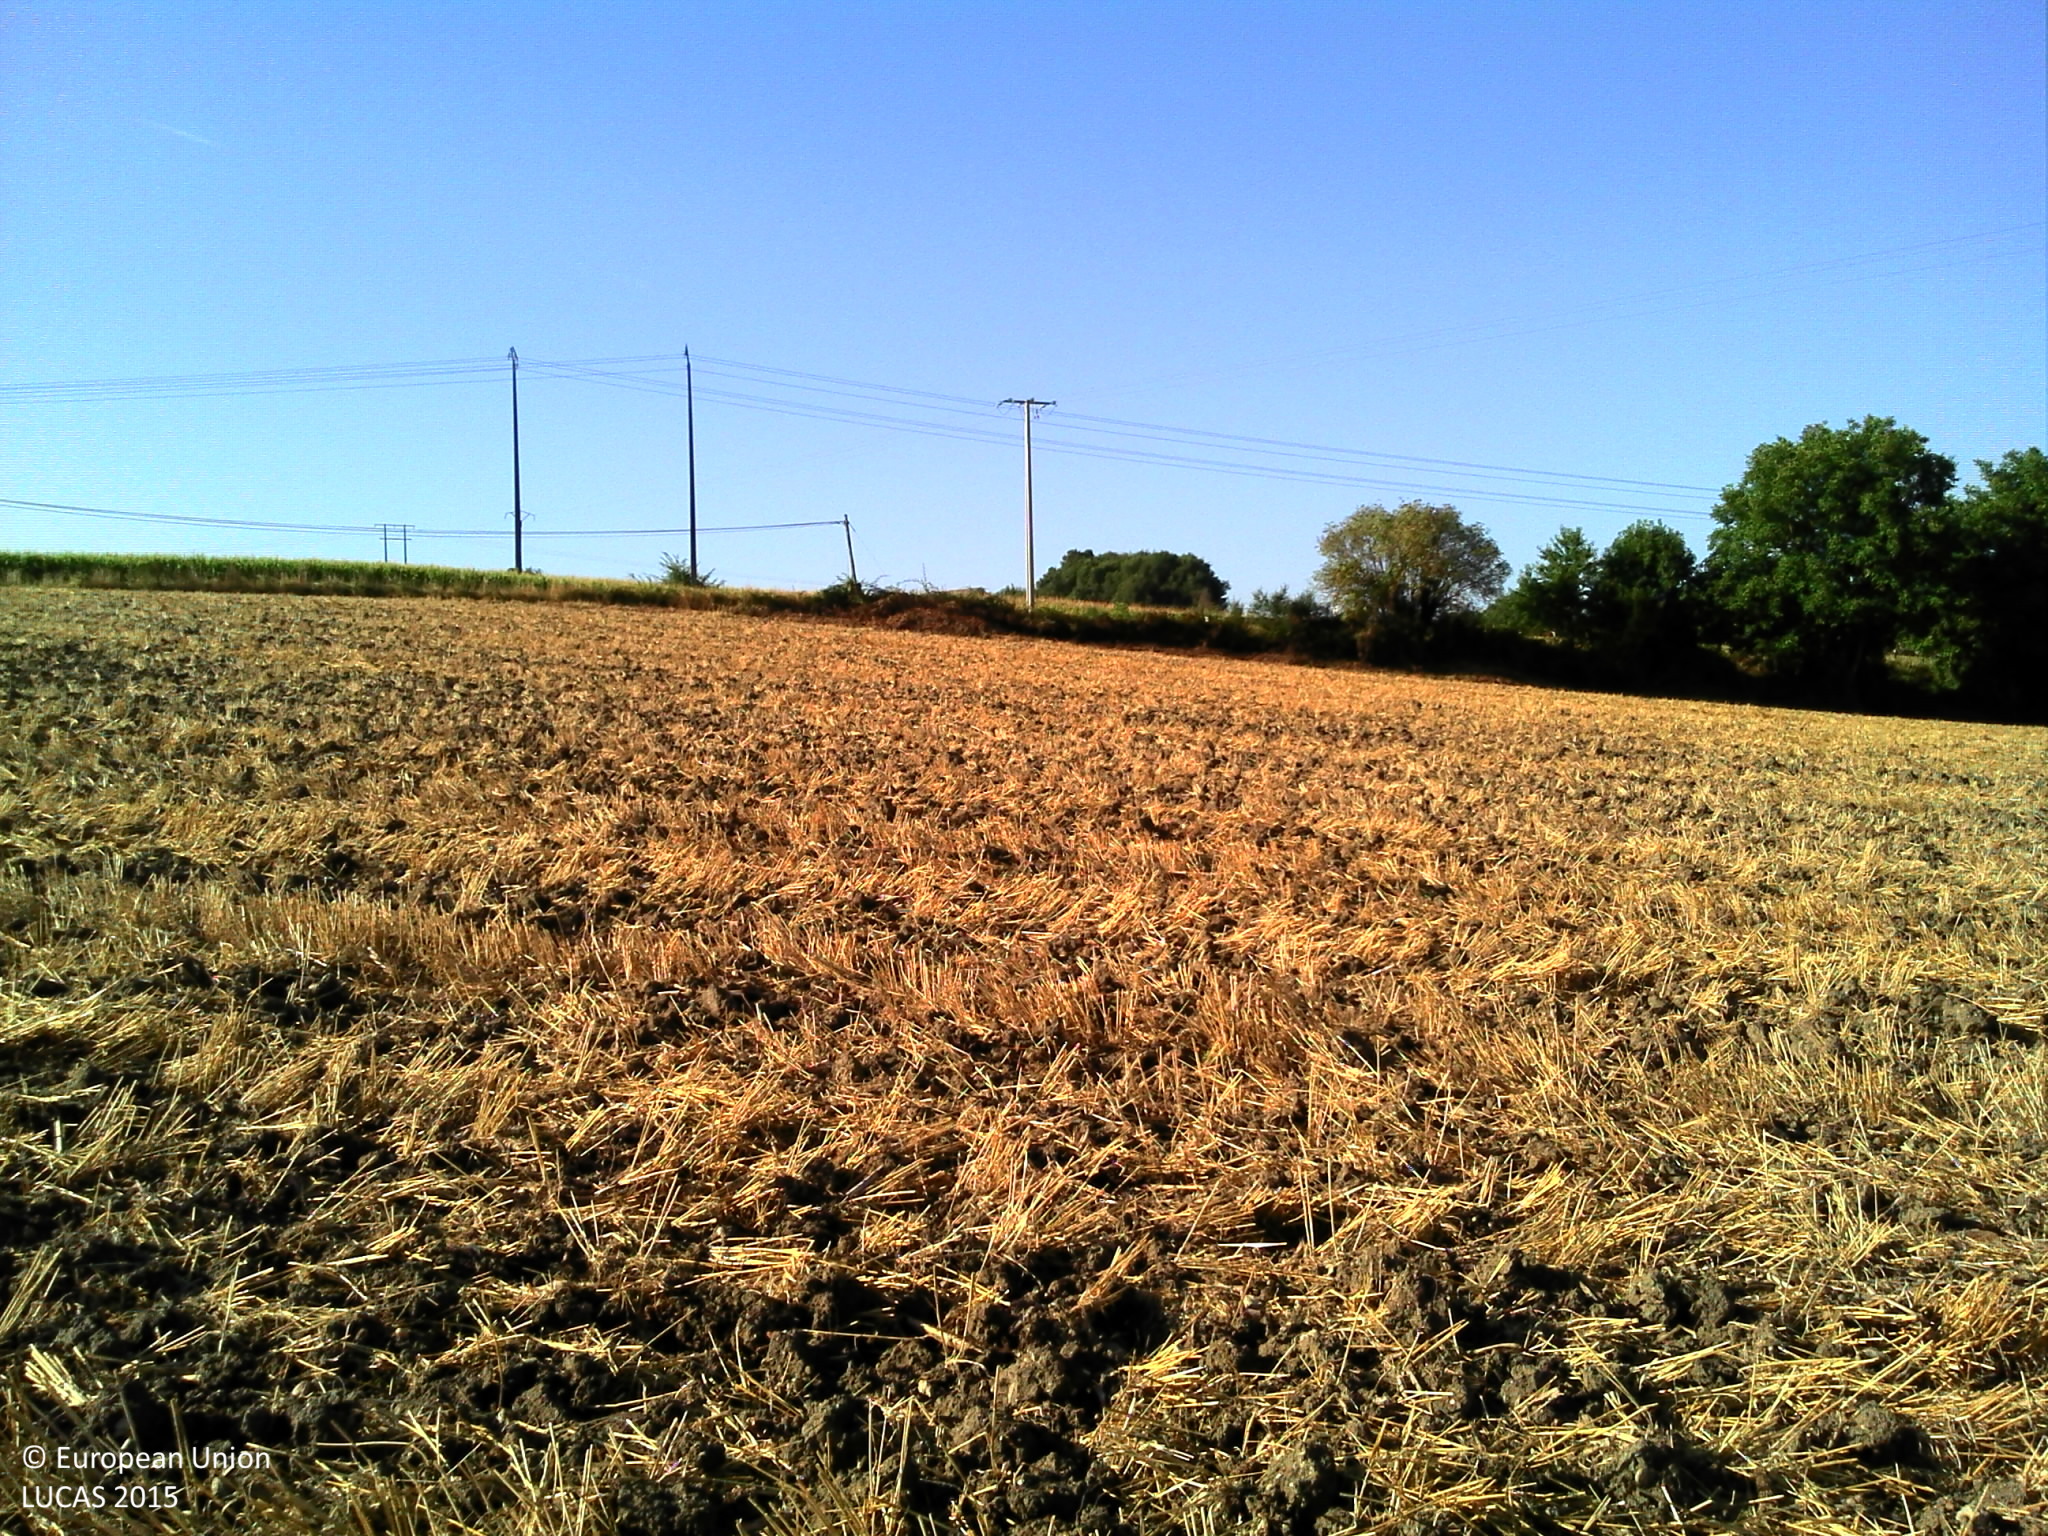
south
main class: Cropland
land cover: Common wheat
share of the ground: 25 - 50 %
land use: Agriculture (excluding fallow land and kitchen gardens)
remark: Tilled/Sowed
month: August
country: FR
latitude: 46.8387
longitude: 0.5542
